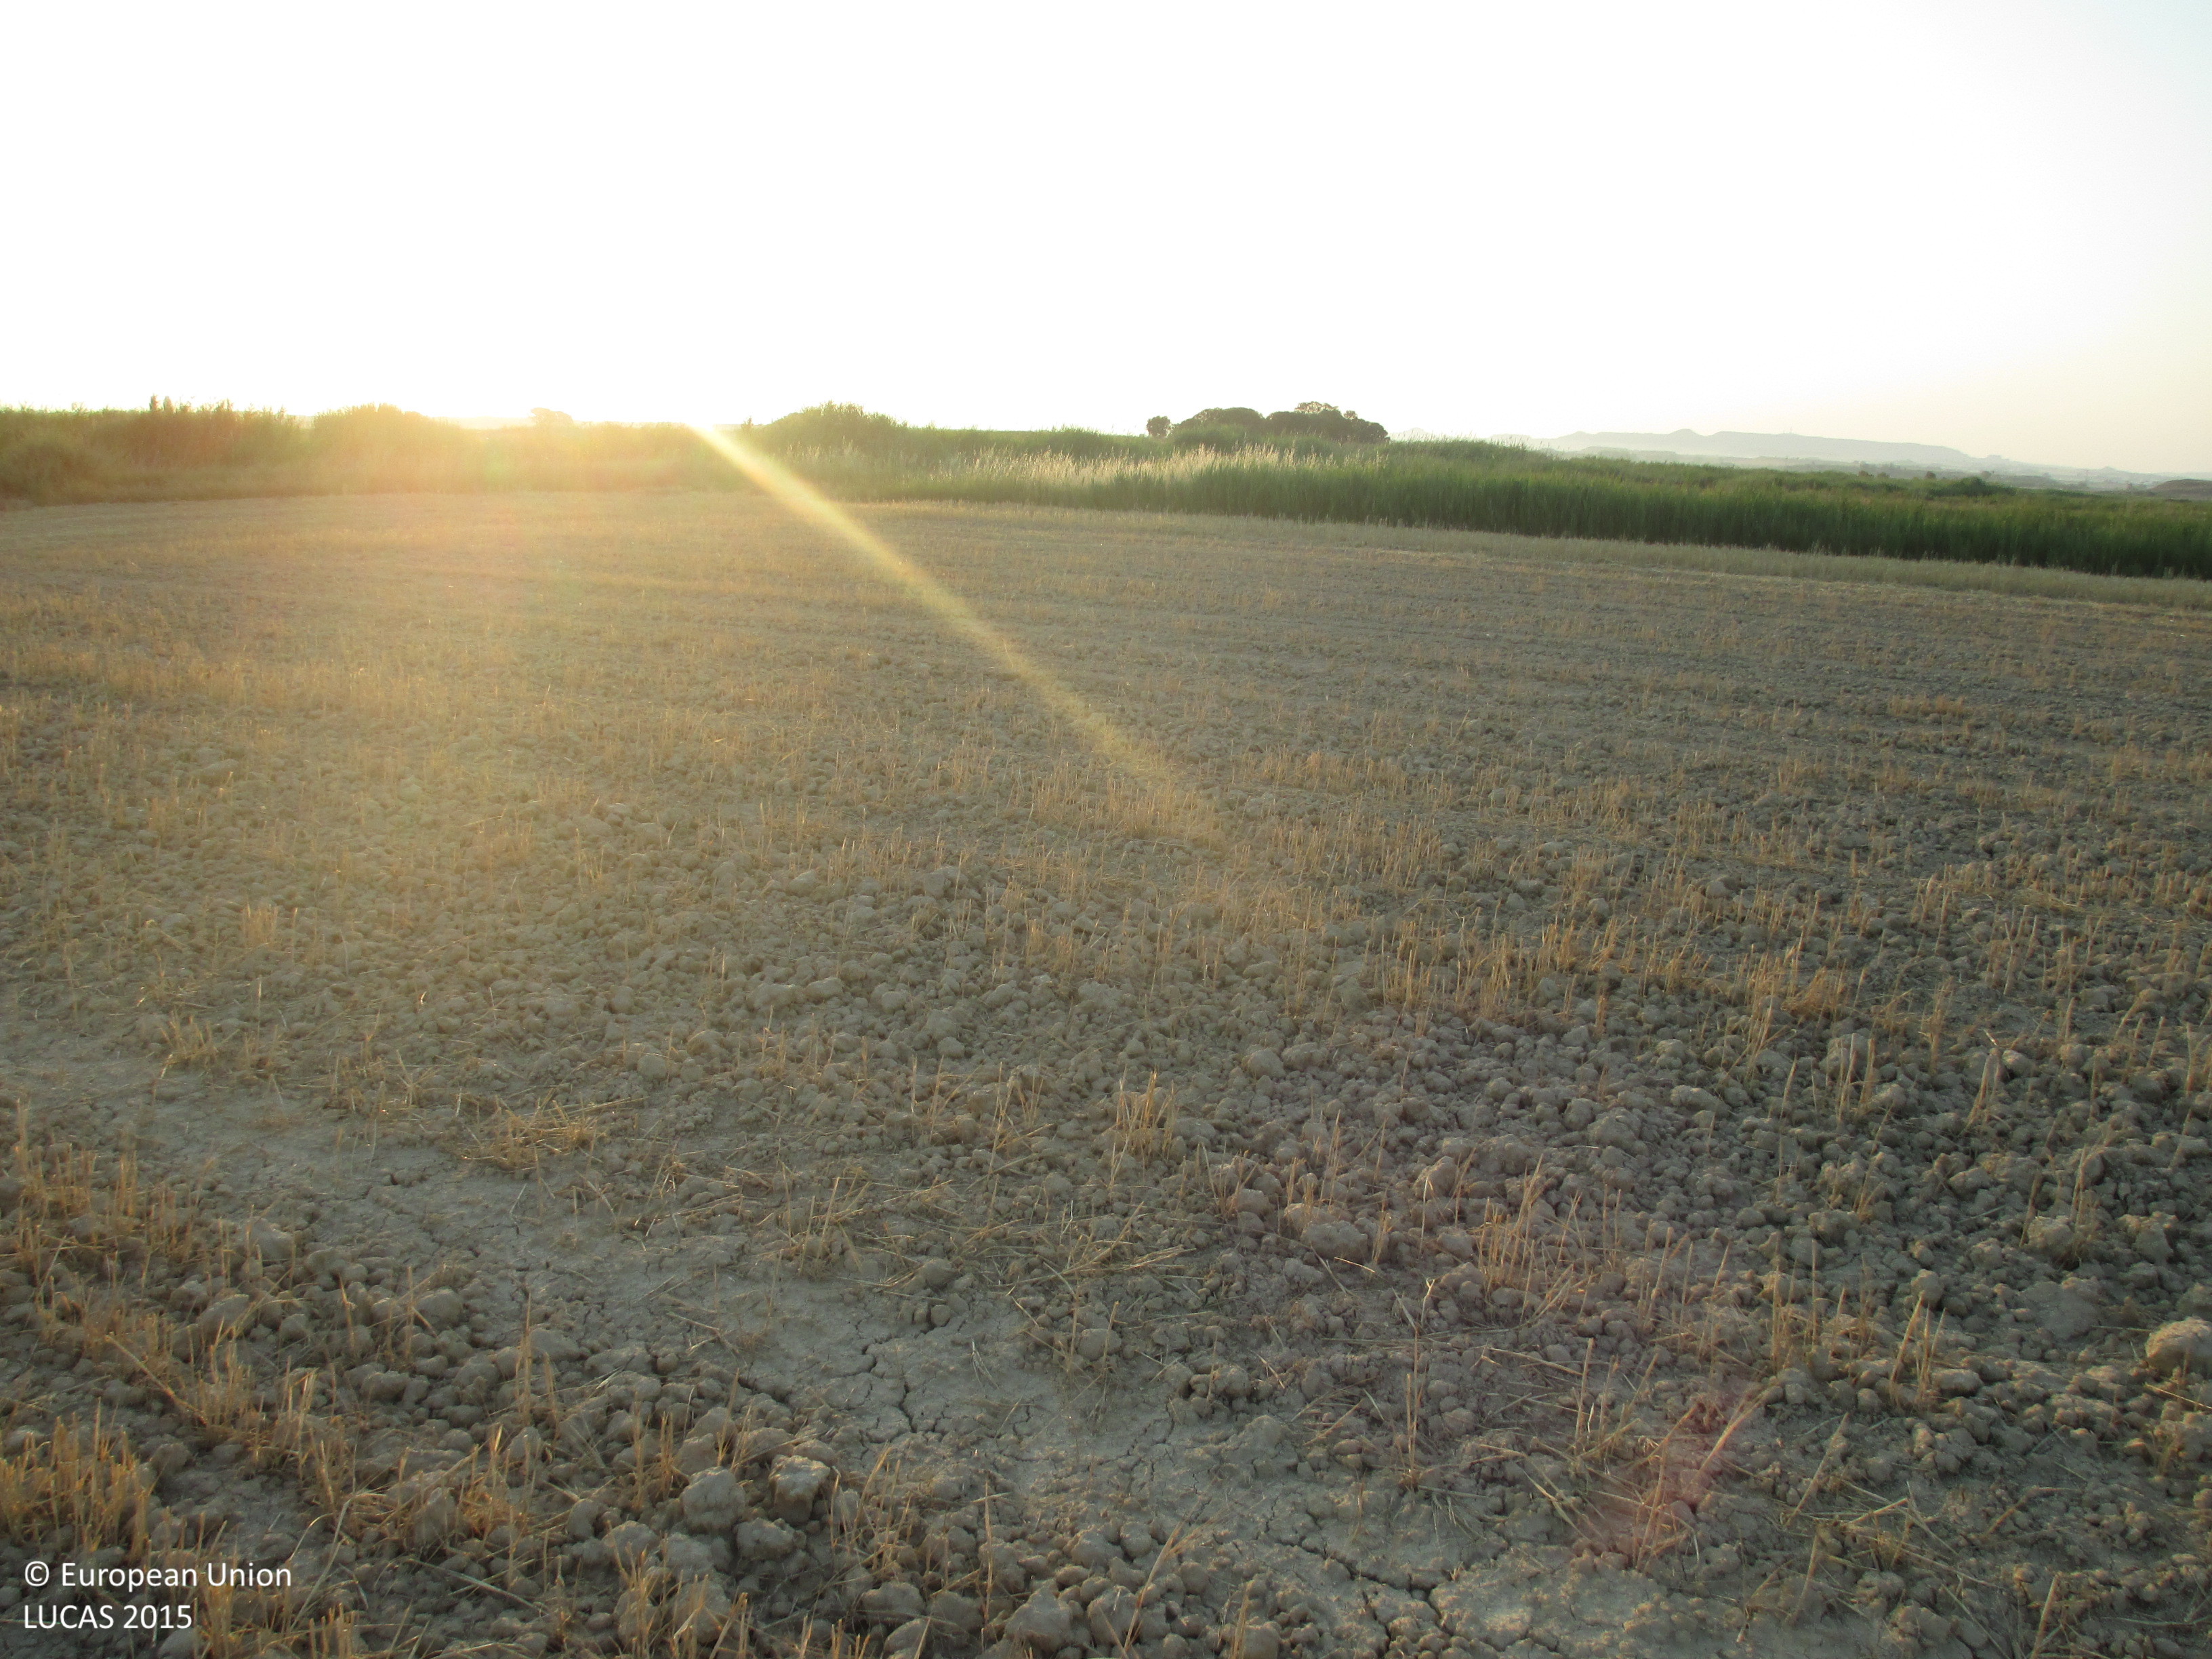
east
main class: Cropland
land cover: Barley
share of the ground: < 10 %
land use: Agriculture (excluding fallow land and kitchen gardens)
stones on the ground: < 10 %
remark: Harvested field
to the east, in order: Barley; Shruby margins; Barley; Shruby margins; Inland fresh running water; Shrubland without tree cover; Other bare soil; Shruby margins; Inland fresh running water; Shrubland without tree cover; Common wheat; Shruby margins; Common wheat; Shruby margins; Common wheat
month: June
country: ES
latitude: 42.0395
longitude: -0.4473
